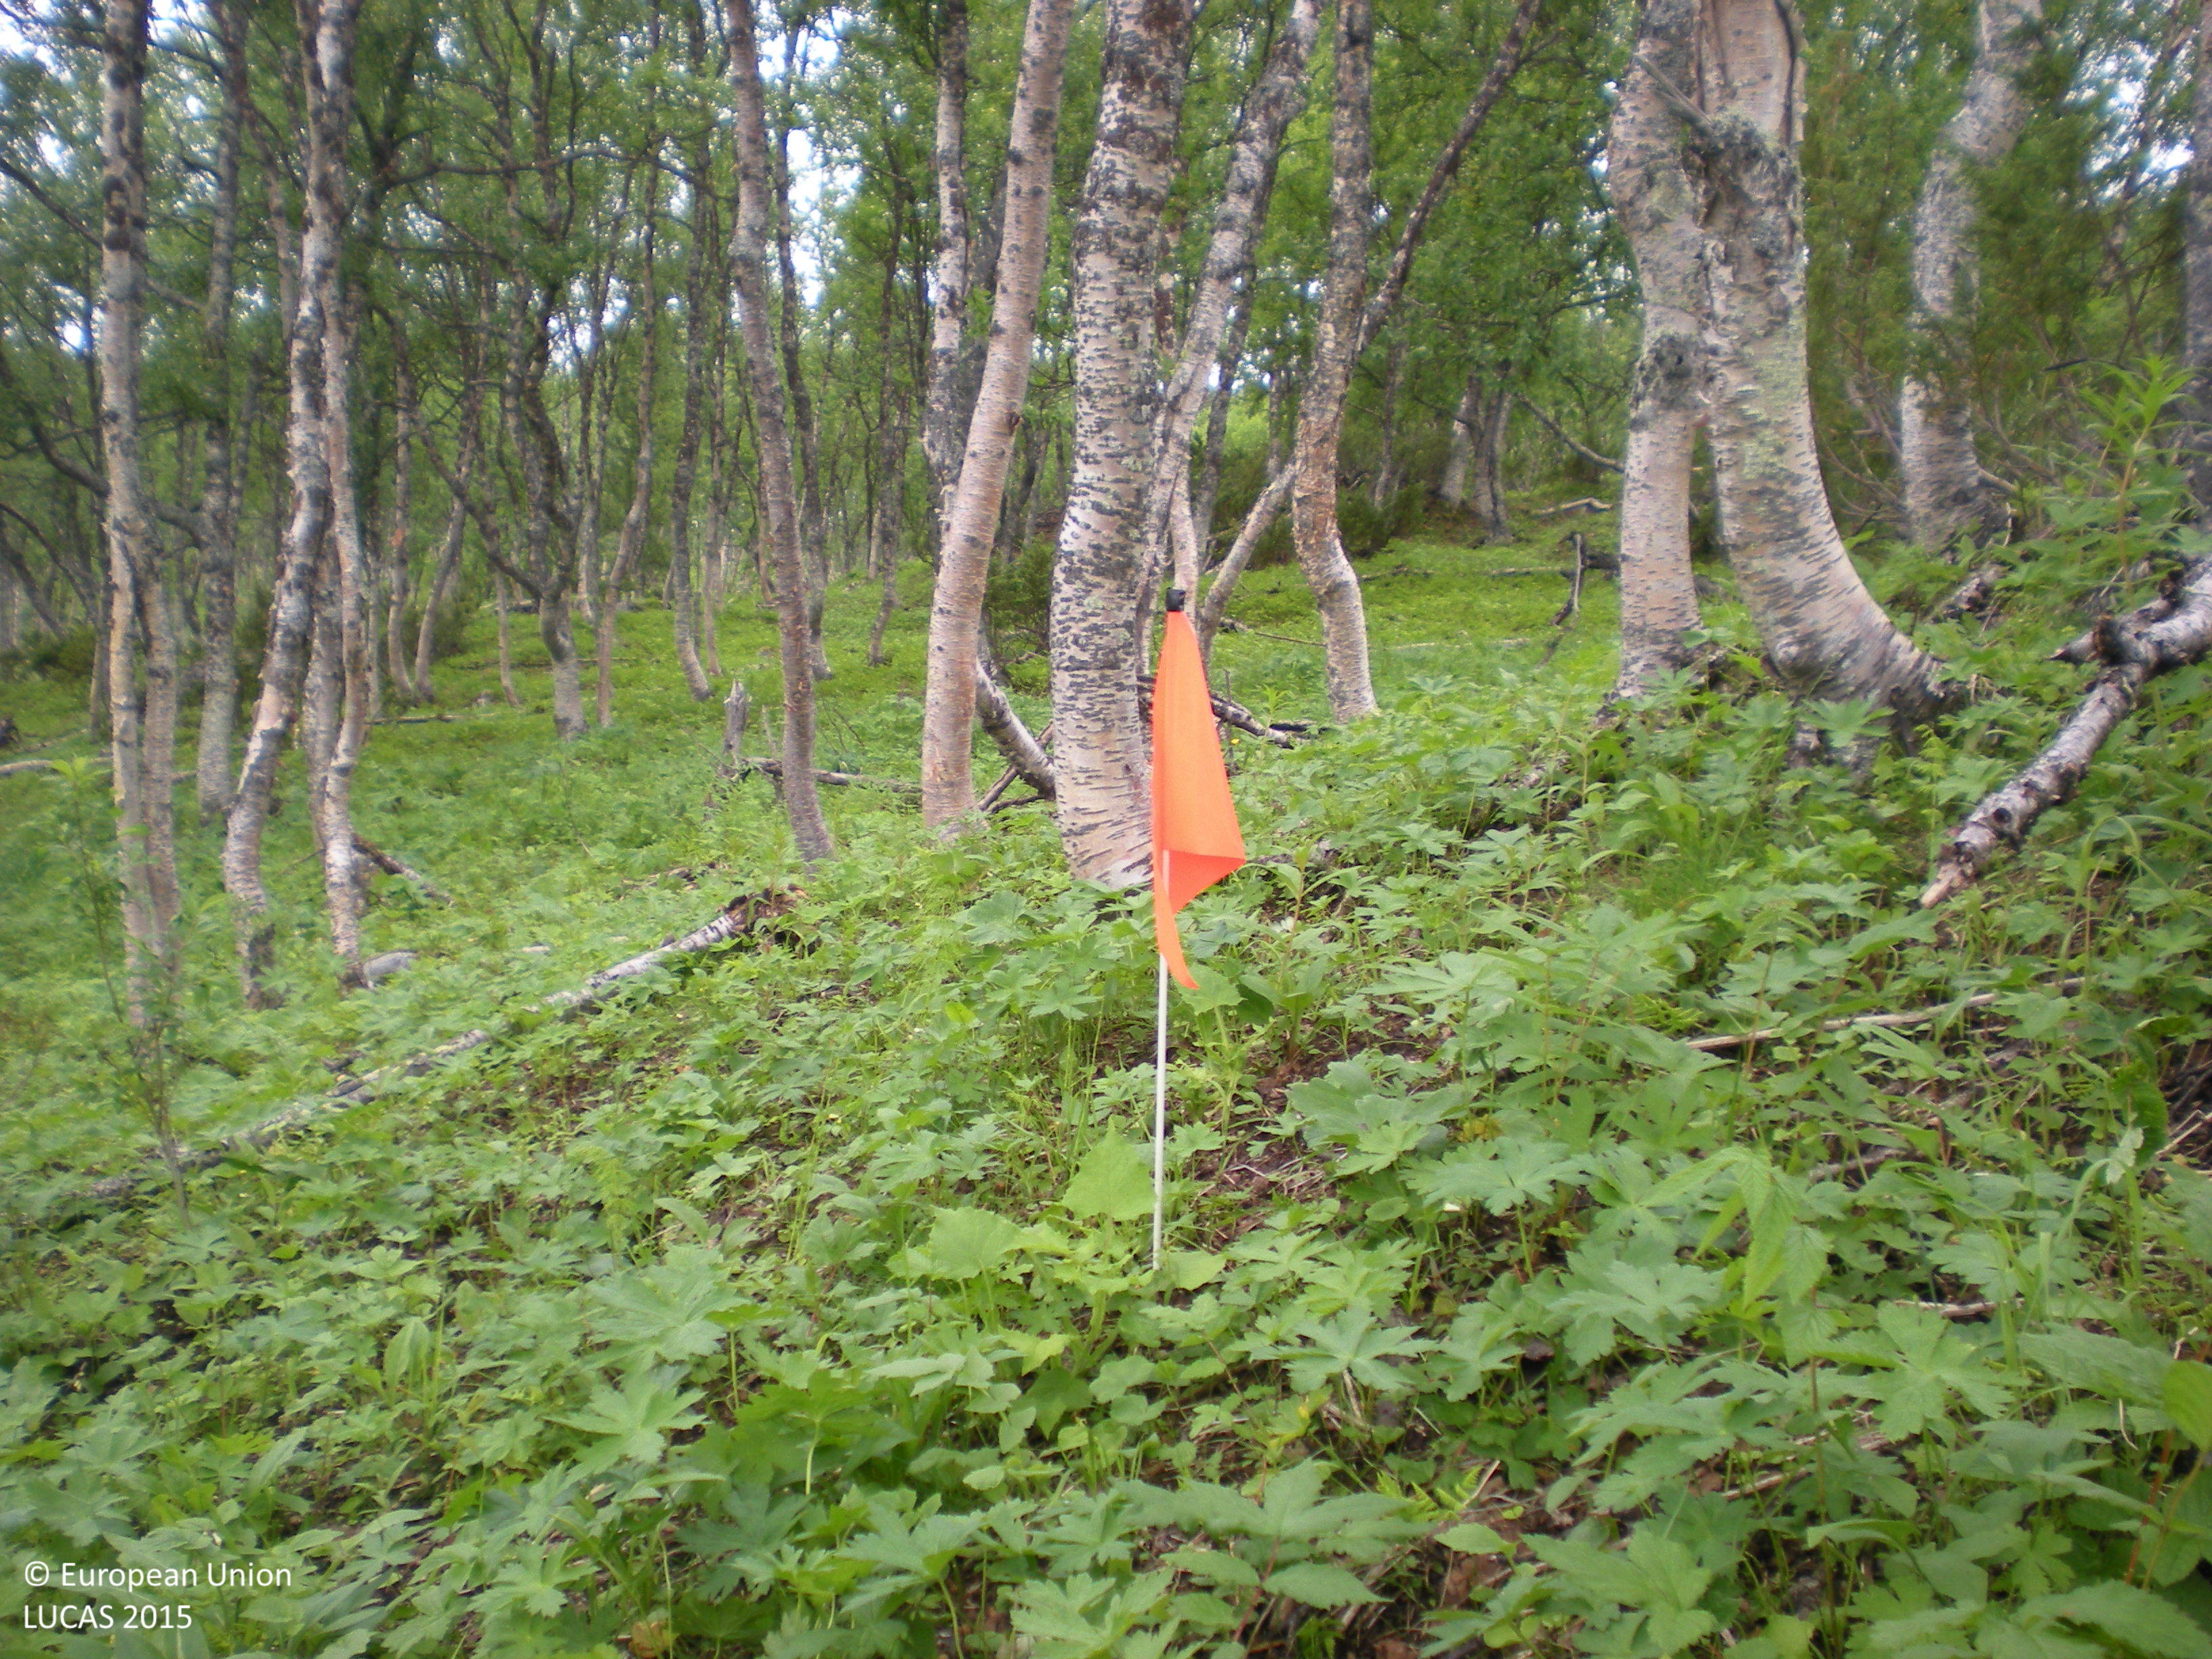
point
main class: Woodland
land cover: Broadleaved woodland
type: boreal forest
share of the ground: 50 - 75 %
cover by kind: broadleaved forest trees 55 %, herbaceous plants 30 %, shrubs 15 %
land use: Semi-natural and natural areas not in use
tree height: > 5 m
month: August
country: SE
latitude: 66.6737
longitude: 16.1332
